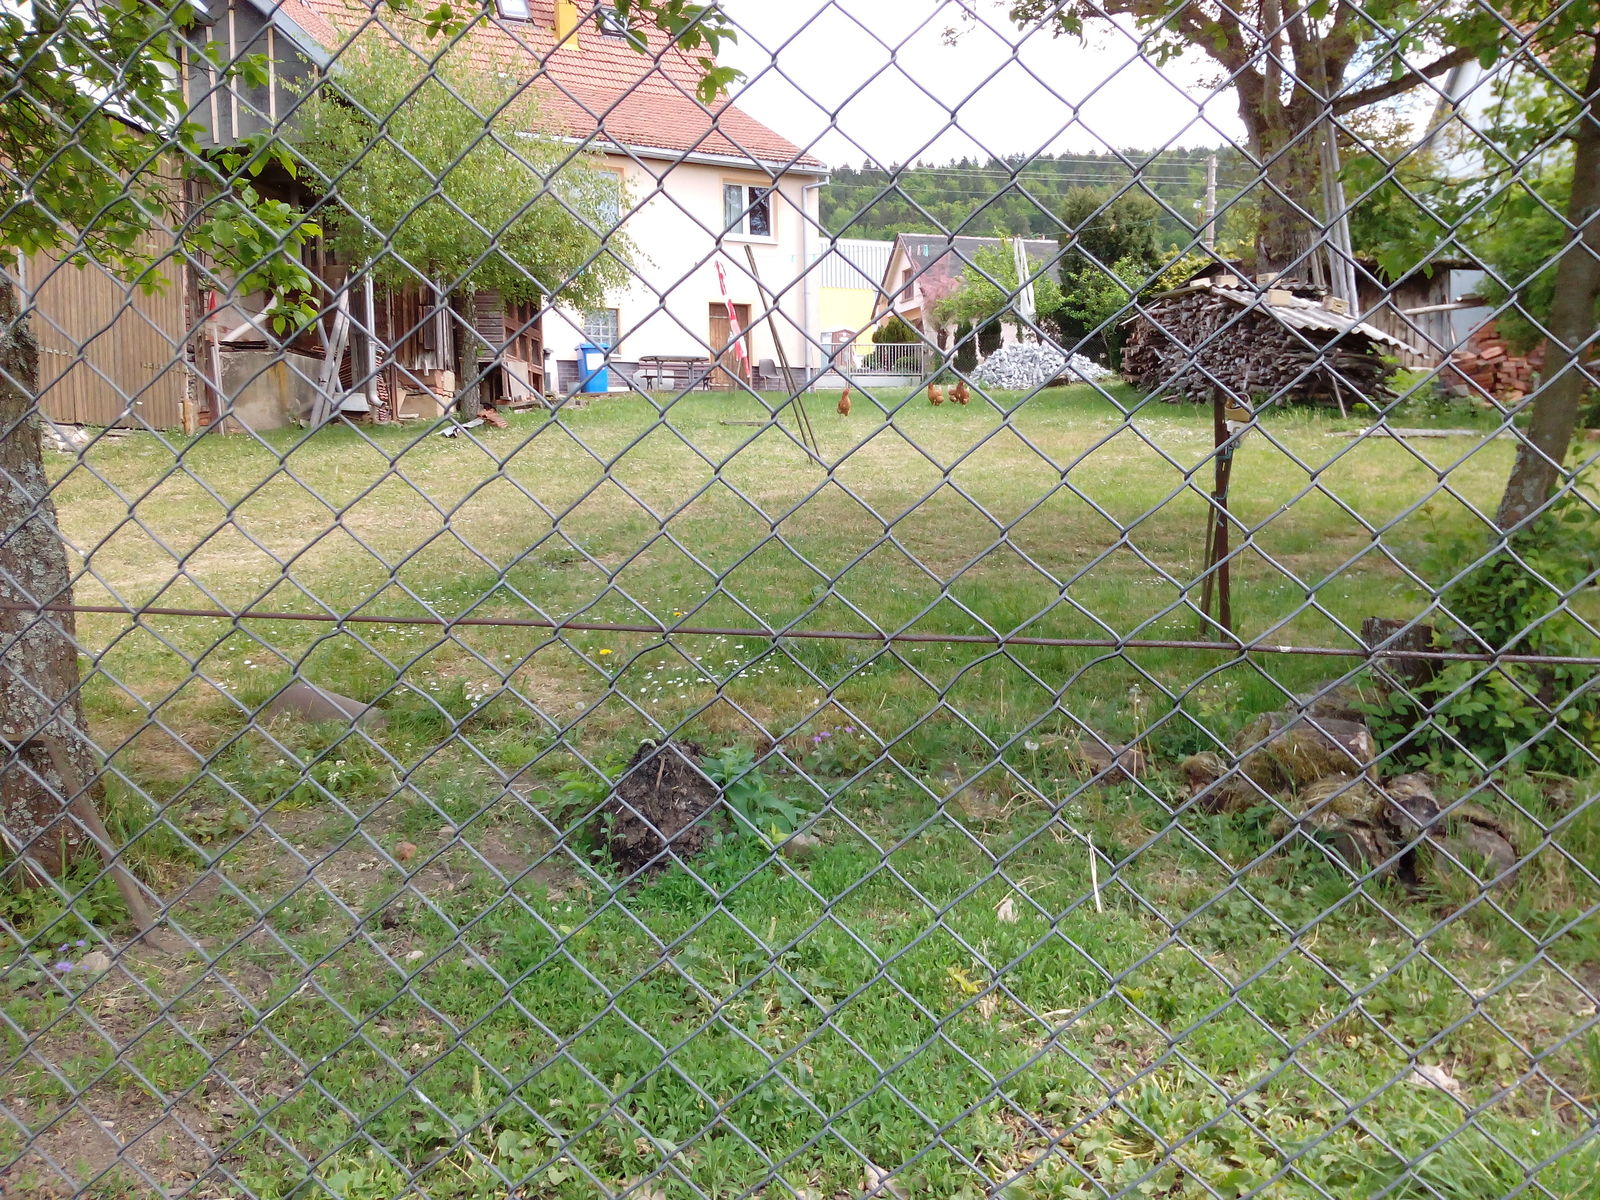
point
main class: Cropland
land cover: Other fruit trees and berries
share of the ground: 10 - 25 %
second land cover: Grassland without tree/shrub cover
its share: > 75 %
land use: Kitchen garden
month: May
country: DE
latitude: 50.4131
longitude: 11.0551
